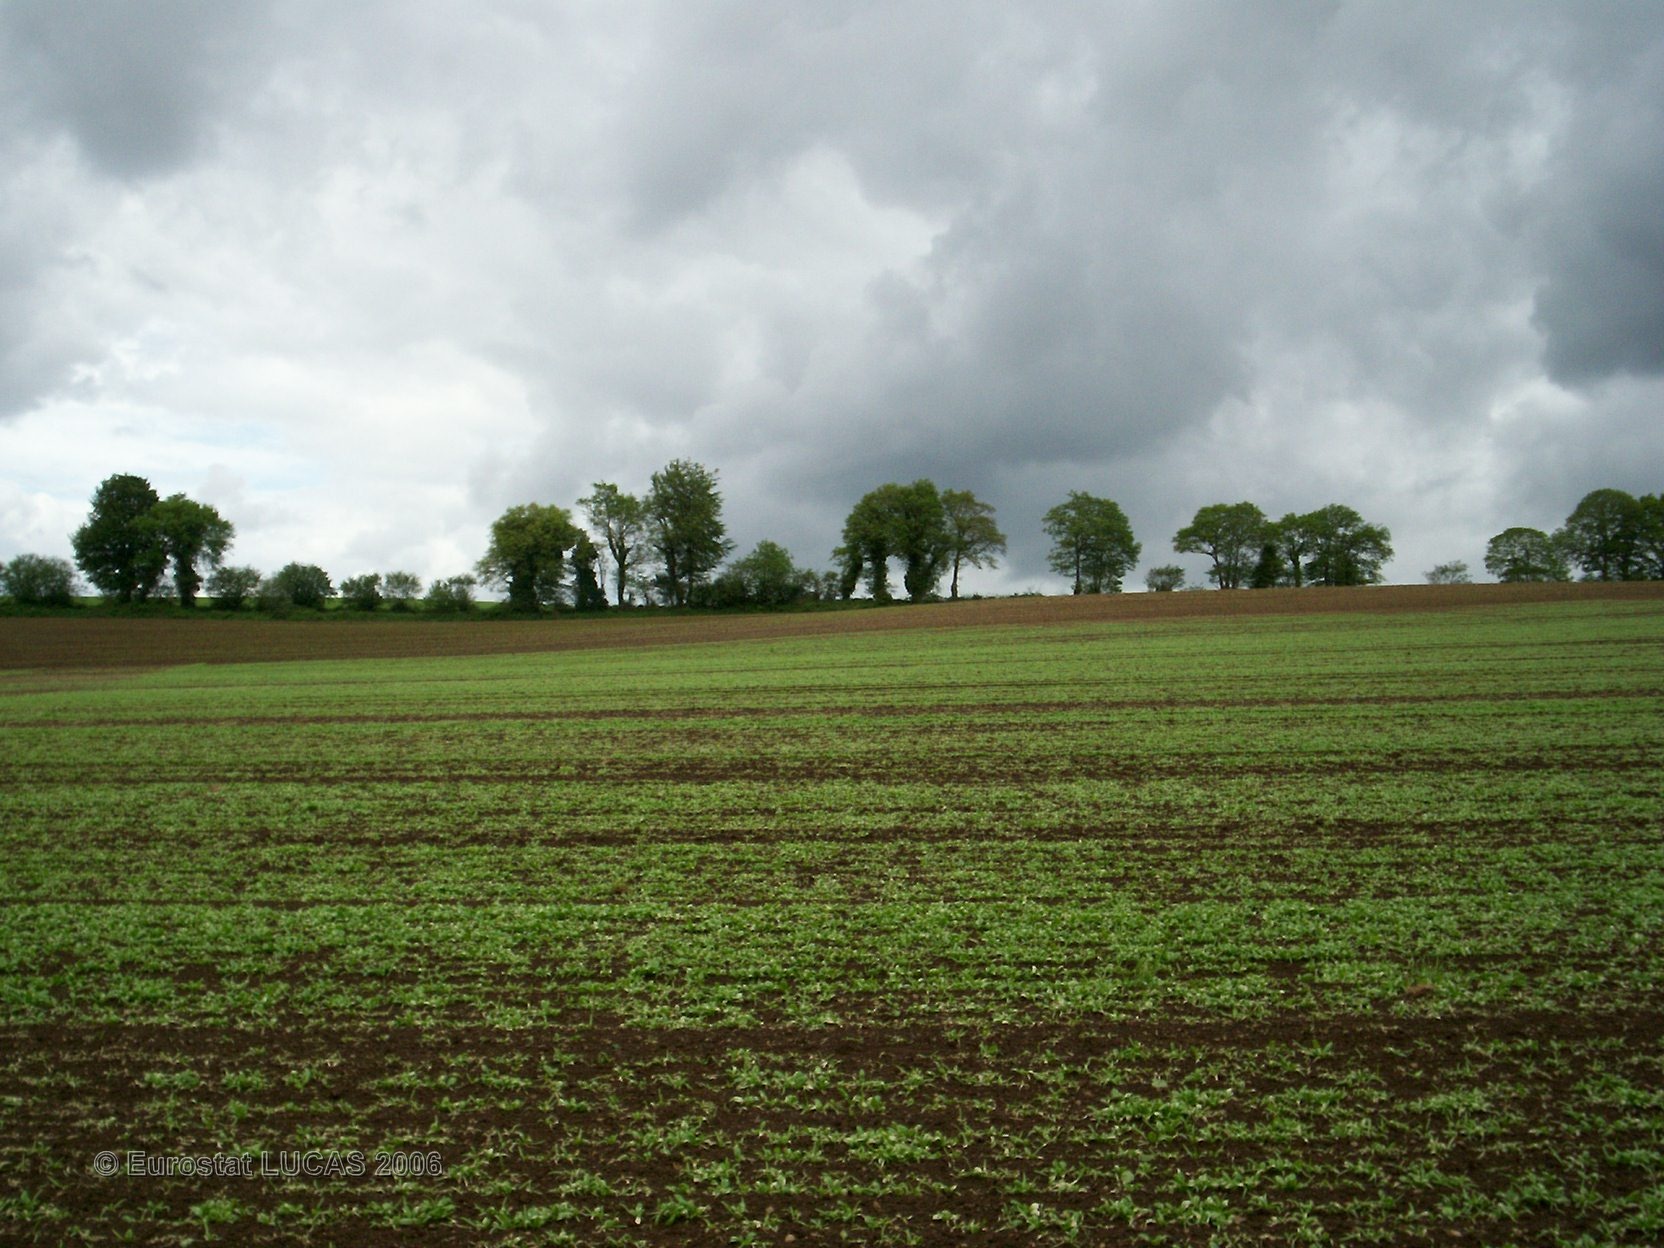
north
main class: Cropland
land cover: Other fresh vegetables
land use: Agriculture (excluding fallow land and kitchen gardens)
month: May
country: FR
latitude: 48.1472
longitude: -3.5596
